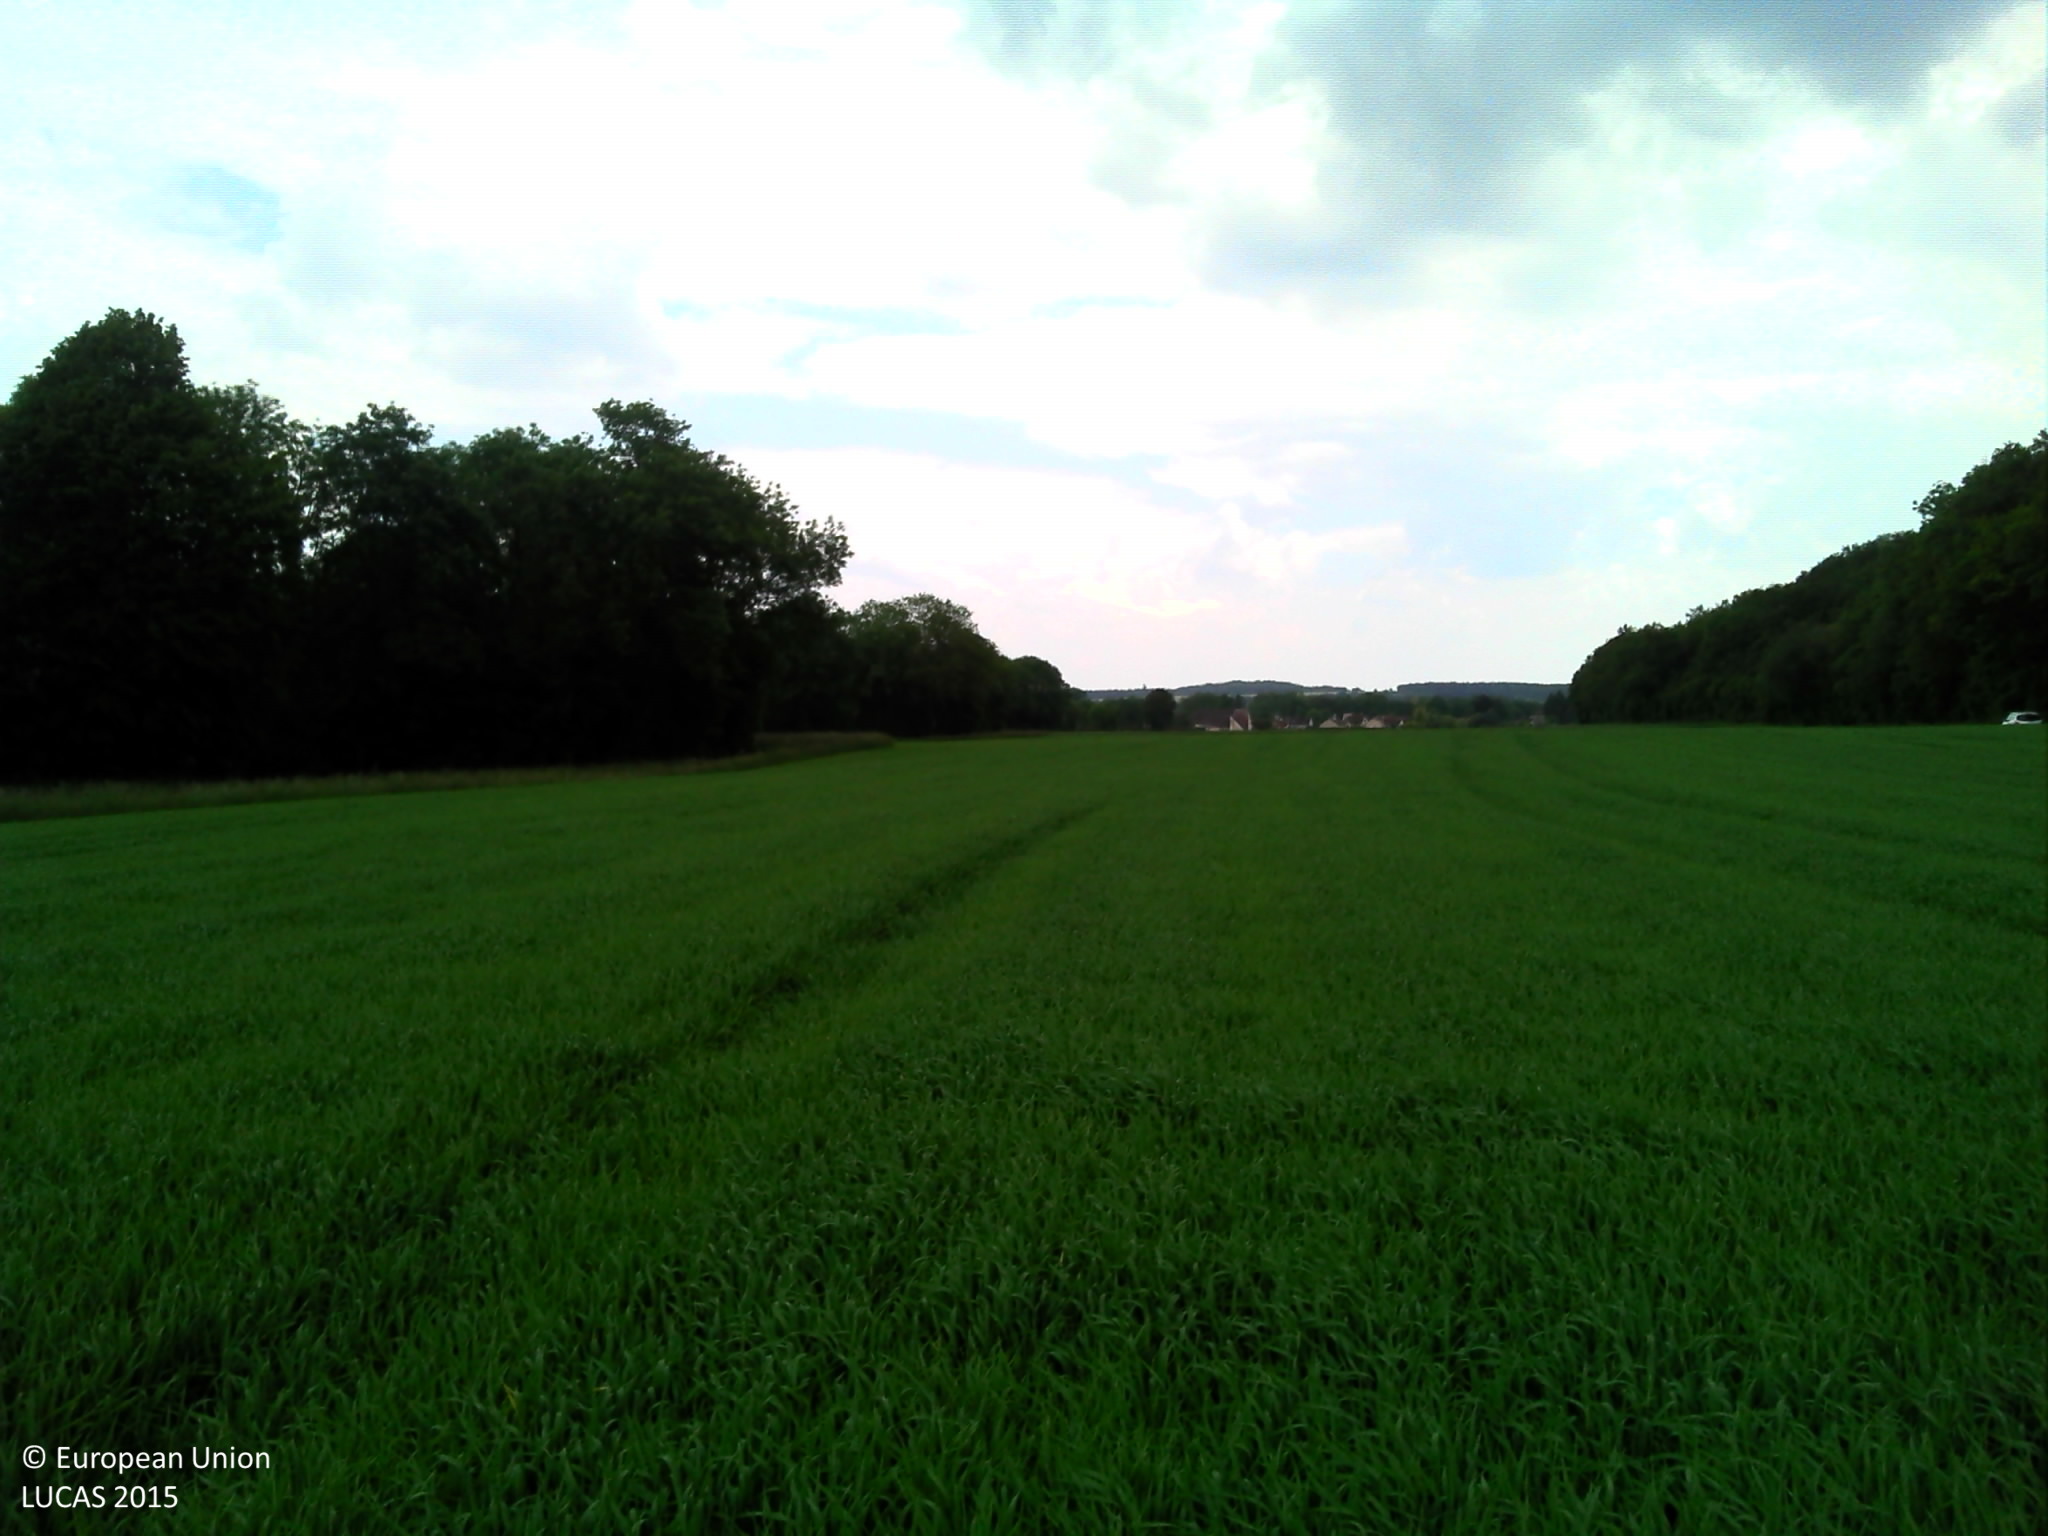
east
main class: Cropland
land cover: Barley
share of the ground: > 75 %
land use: Agriculture (excluding fallow land and kitchen gardens)
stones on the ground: < 10 %
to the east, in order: Barley; Grassland without tree/shrub cover; Lines of trees; Rivers and streams; Lines of trees; Grassland without tree/shrub cover; Common wheat; Grassland without tree/shrub cover
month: May
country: FR
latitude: 47.4071
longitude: 5.0043
